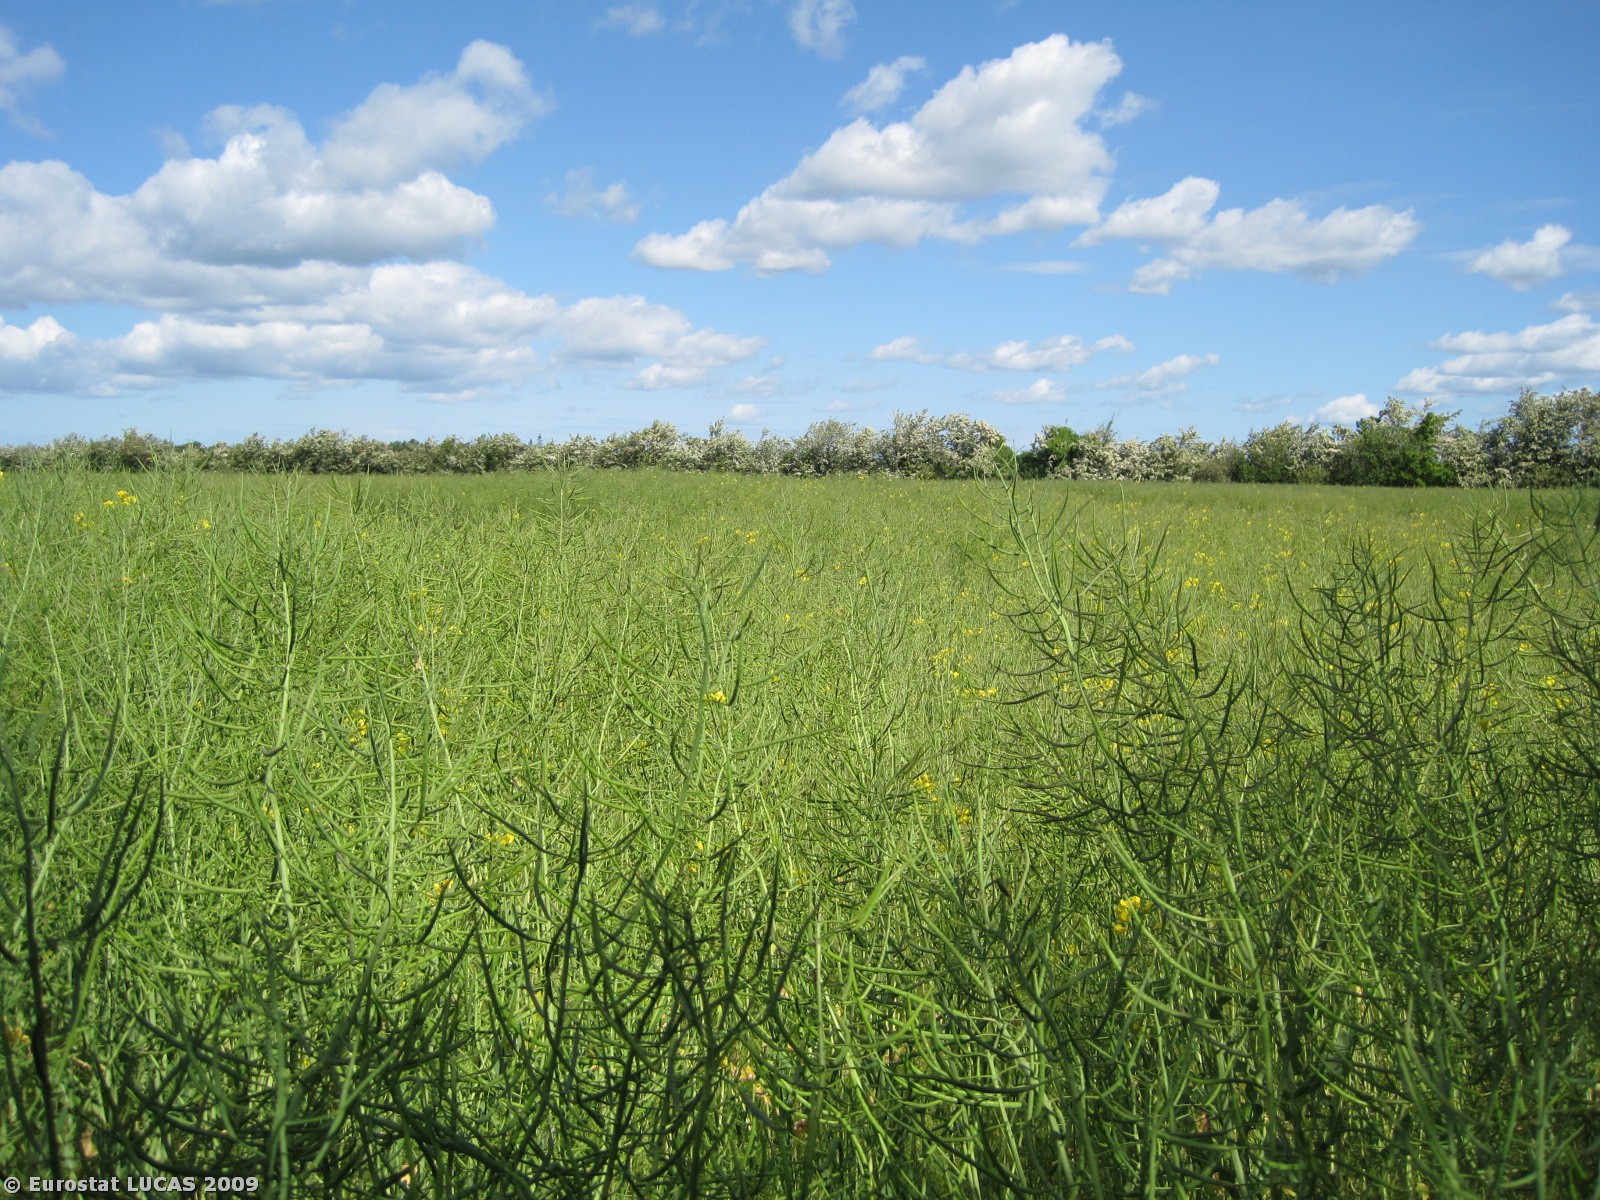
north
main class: Cropland
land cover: Rape and turnip rape
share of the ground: > 75 %
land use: Agriculture (excluding fallow land and kitchen gardens)
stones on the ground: < 10 %
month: June
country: DK
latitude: 56.9426
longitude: 10.2134
